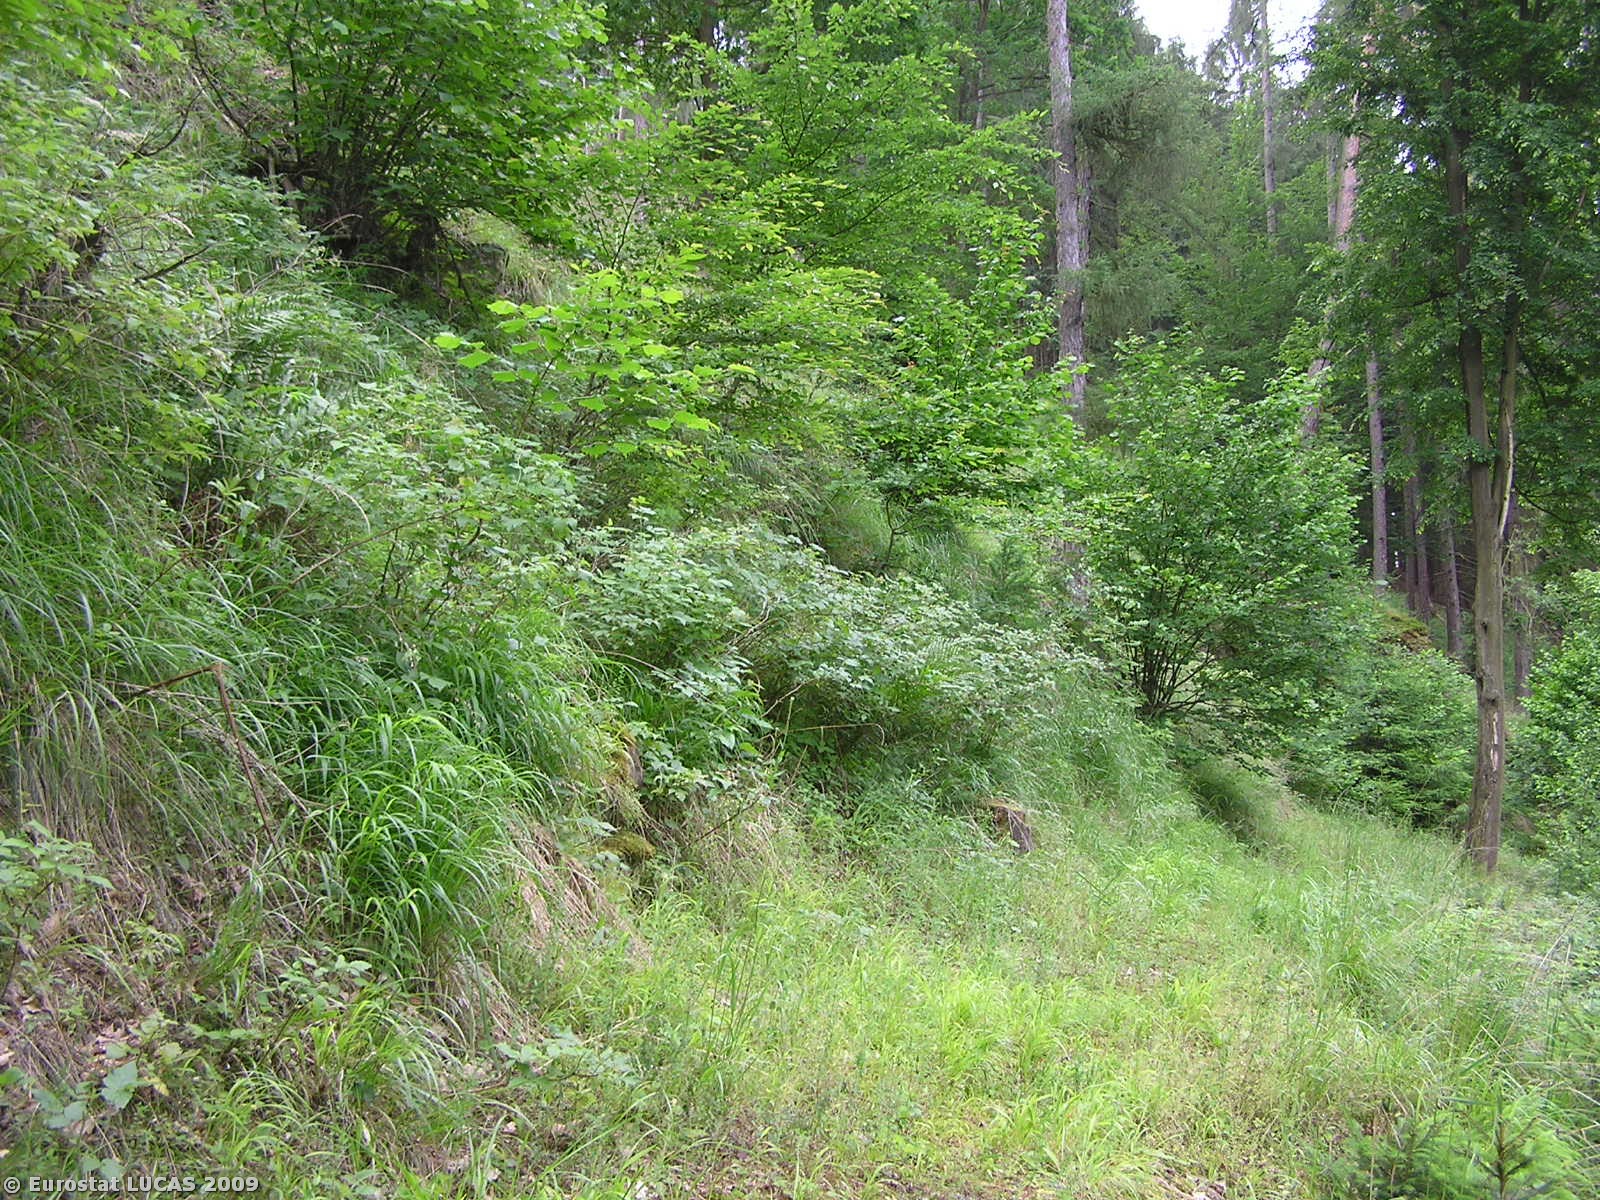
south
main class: Woodland
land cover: Mixed woodland
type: hemiboreal forest and nemoral coniferous forest and mixed broadleaved-coniferous forest
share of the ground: 50 - 75 %
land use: Forestry
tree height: > 5 m
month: June
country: CZ
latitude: 49.7662
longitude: 14.6251
